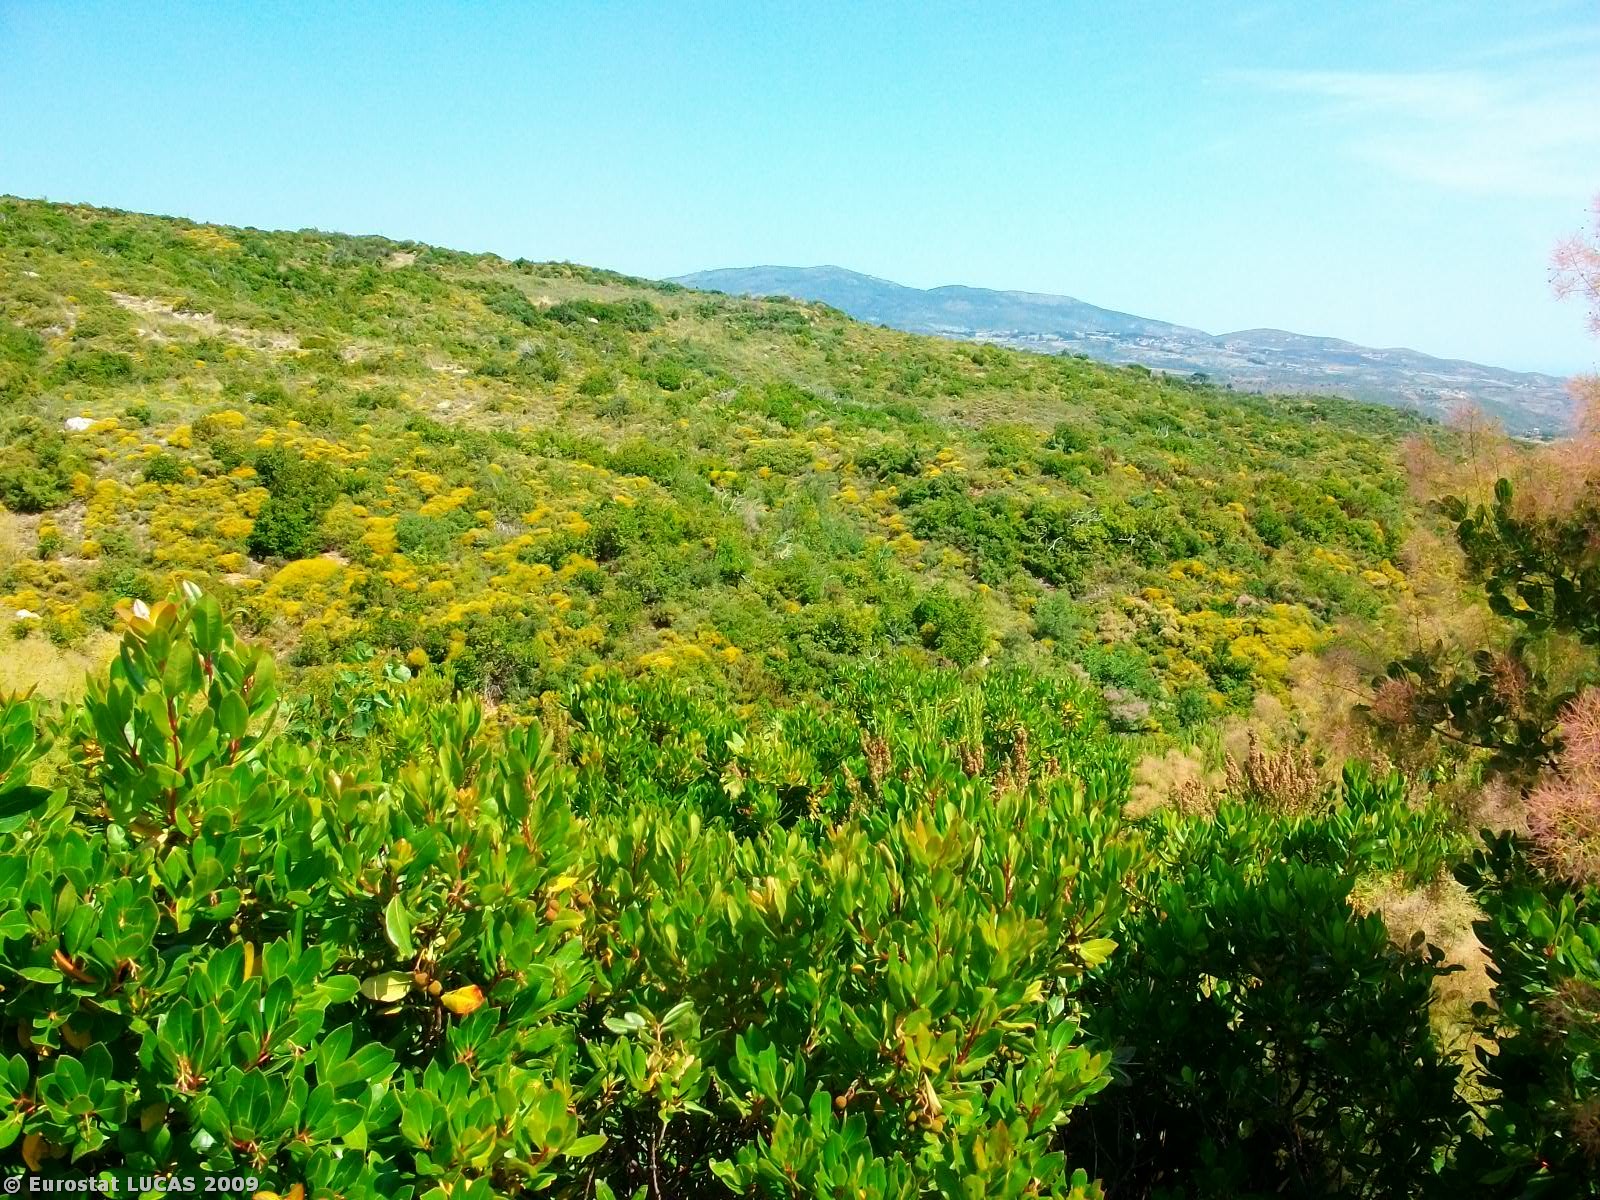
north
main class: Shrubland
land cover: Shrubland without tree cover
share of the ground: > 75 %
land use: Unused
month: June
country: GR
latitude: 39.2350
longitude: 23.2580
